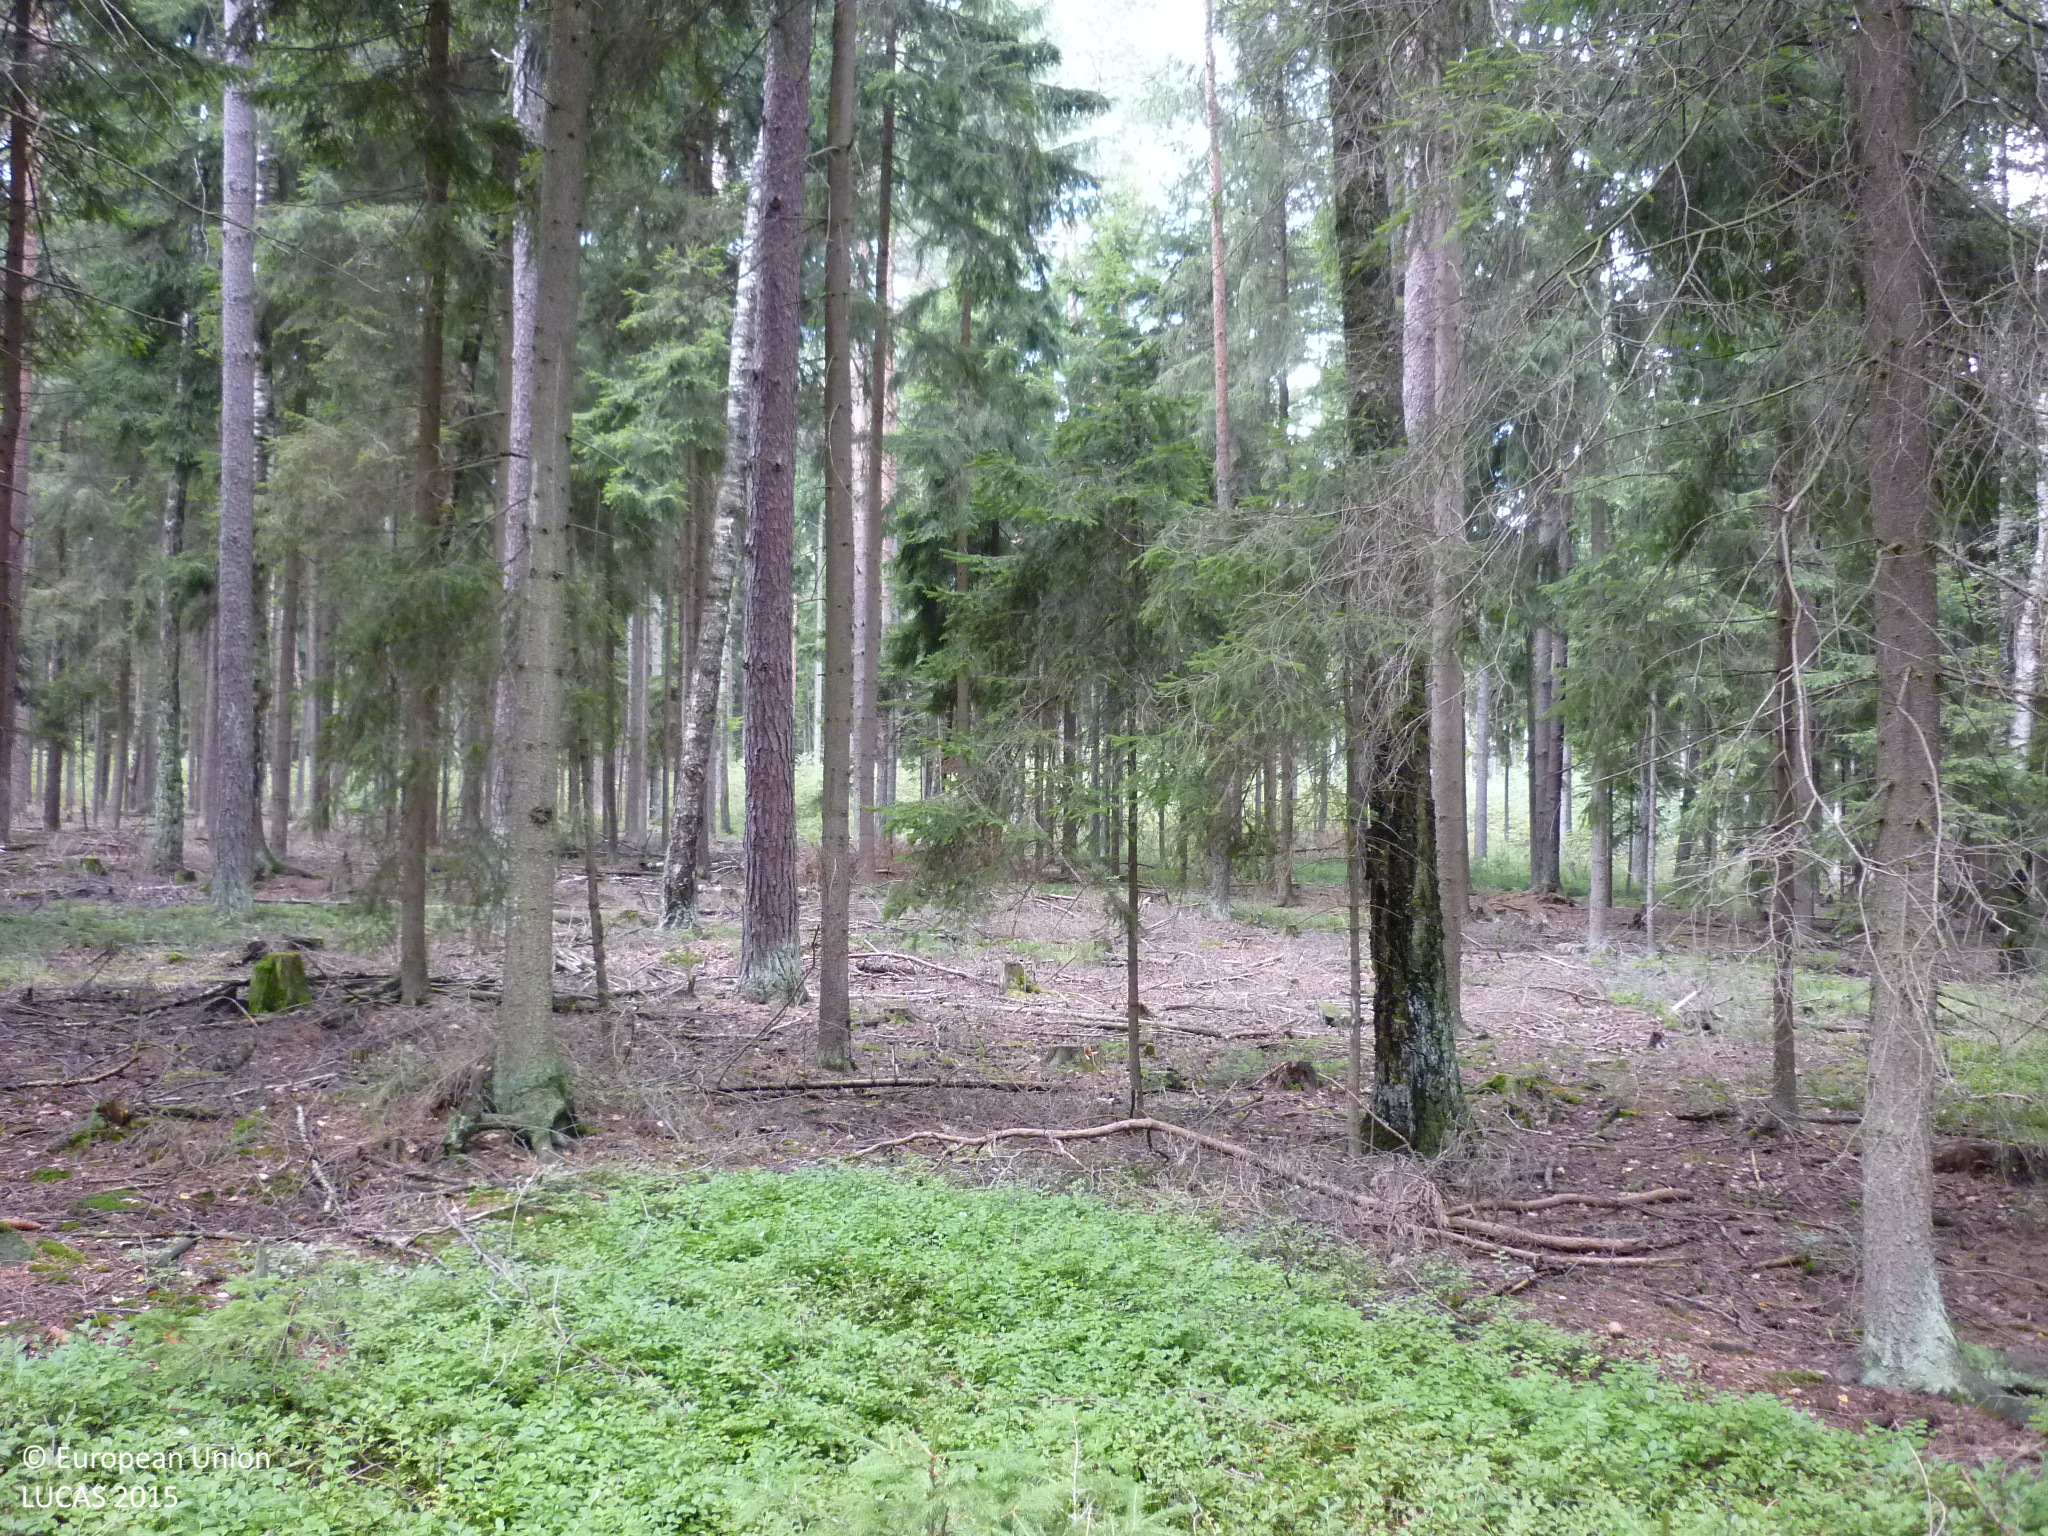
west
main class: Woodland
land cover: Spruce dominated coniferous woodland
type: hemiboreal forest and nemoral coniferous forest and mixed broadleaved-coniferous forest
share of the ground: > 75 %
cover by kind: coniferous forest trees 95 %, shrubs 5 %
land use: Forestry
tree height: > 5 m
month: September
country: AT
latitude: 48.9351
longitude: 15.0941
